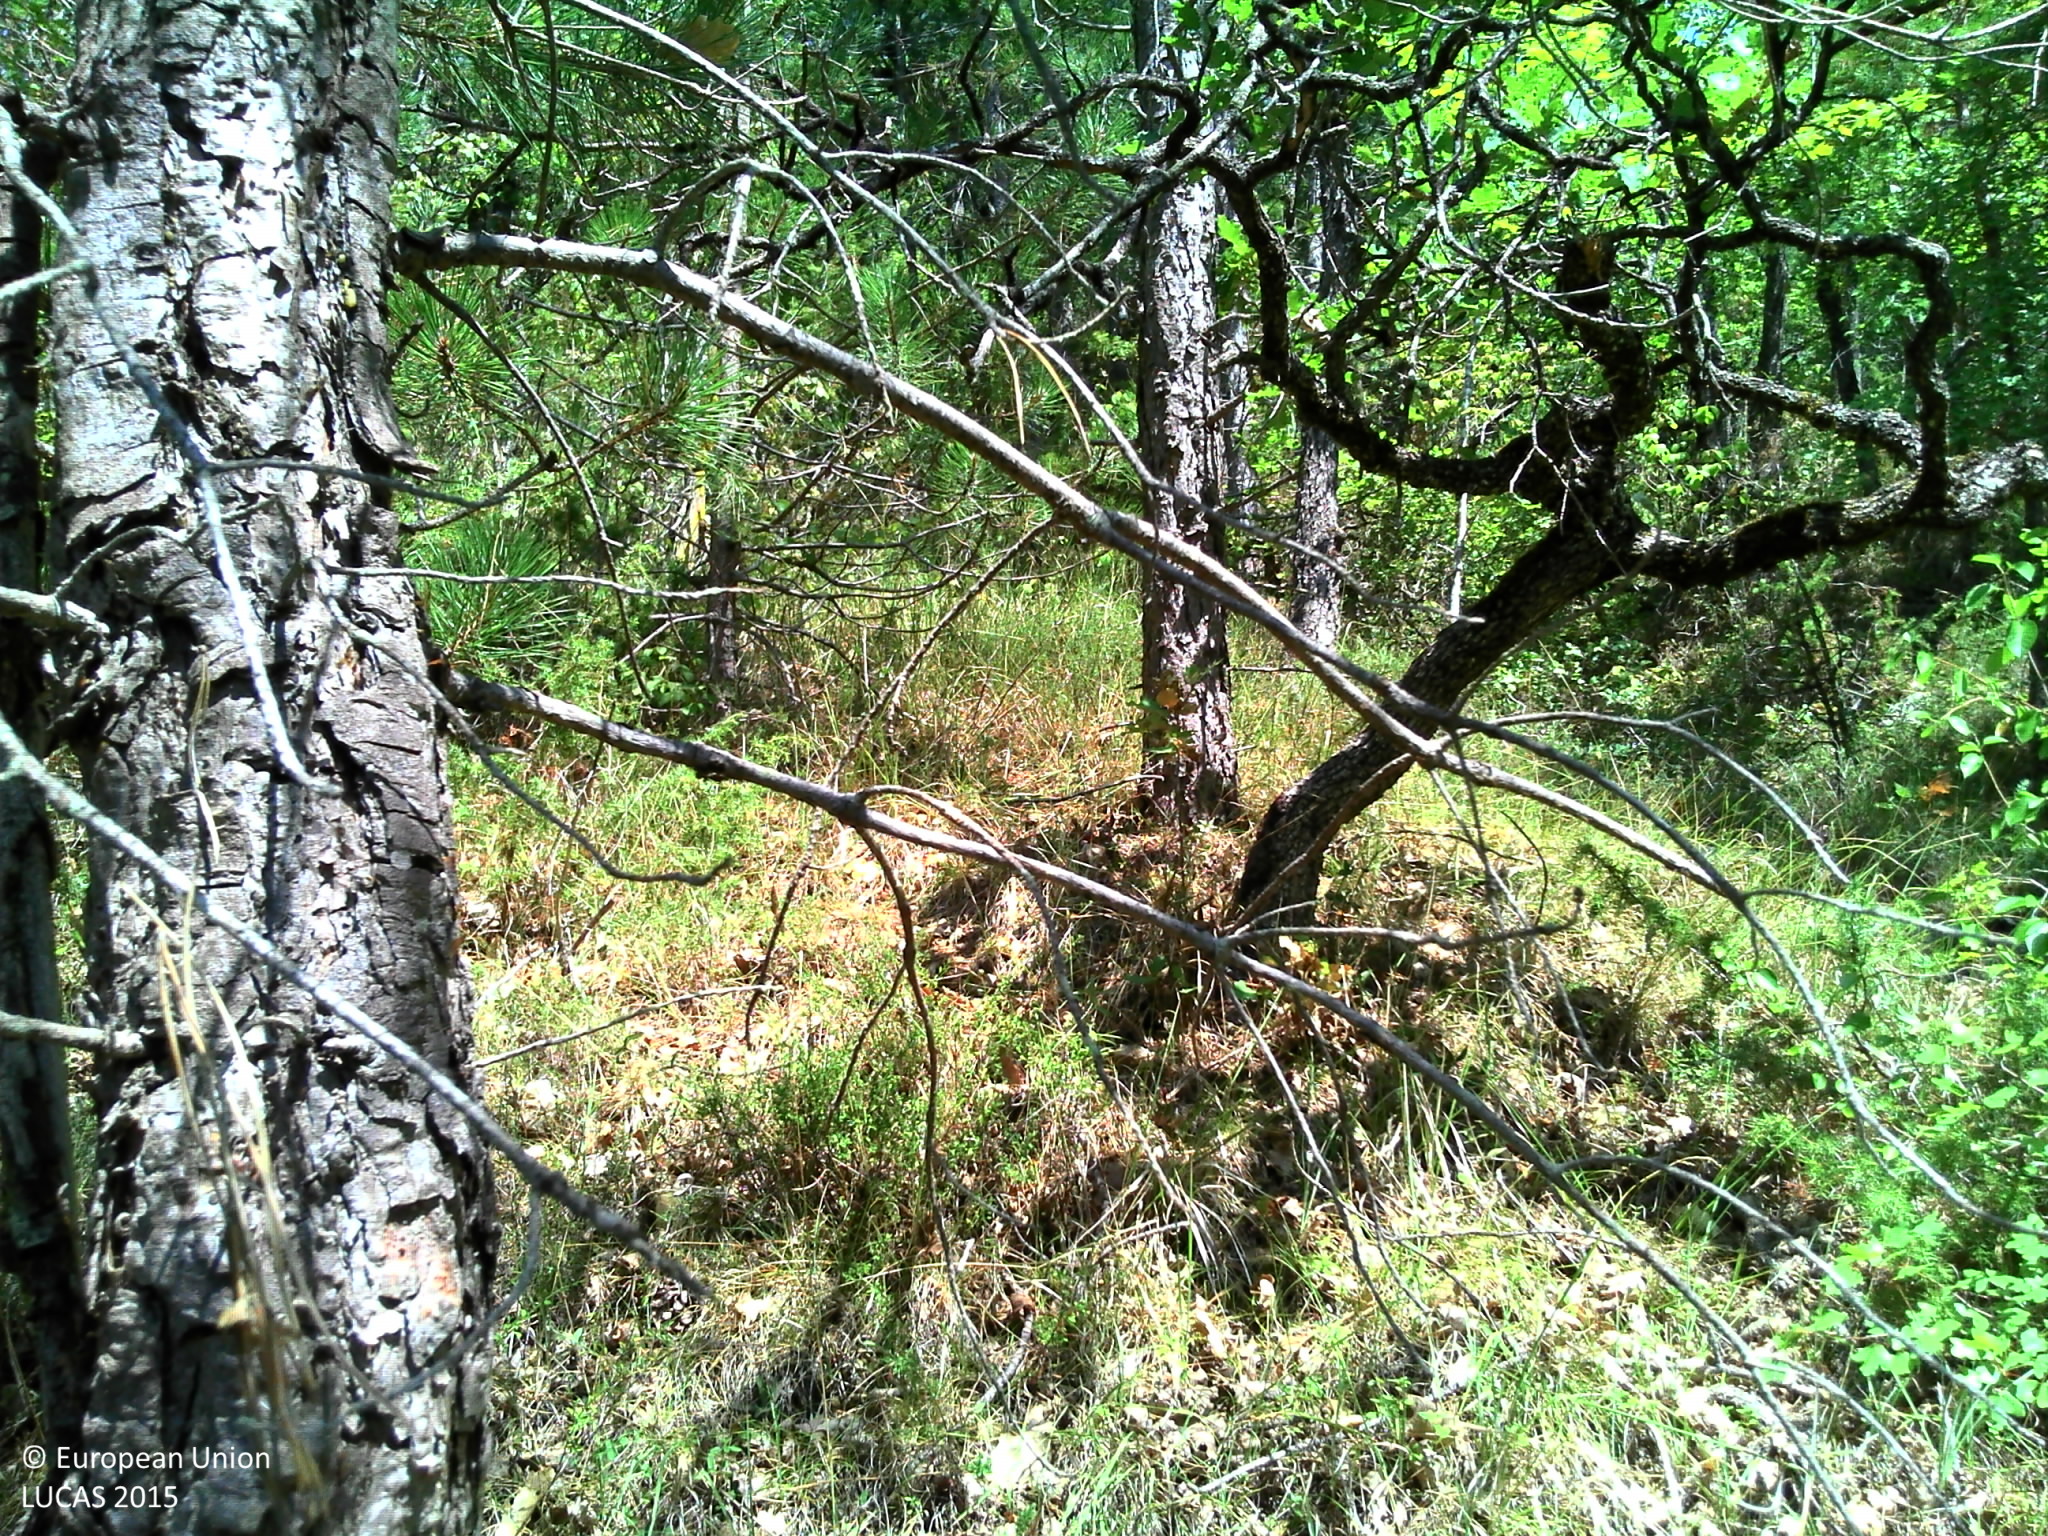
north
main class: Woodland
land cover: Pine dominated mixed woodland
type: thermophilous deciduous forest
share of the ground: 50 - 75 %
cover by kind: coniferous forest trees 40 %, broadleaved forest trees 30 %, shrubs 10 %, herbaceous plants 10 %, lichens and mosses 10 %
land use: Forestry
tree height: > 5 m
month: August
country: FR
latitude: 44.7349
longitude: 1.1684
